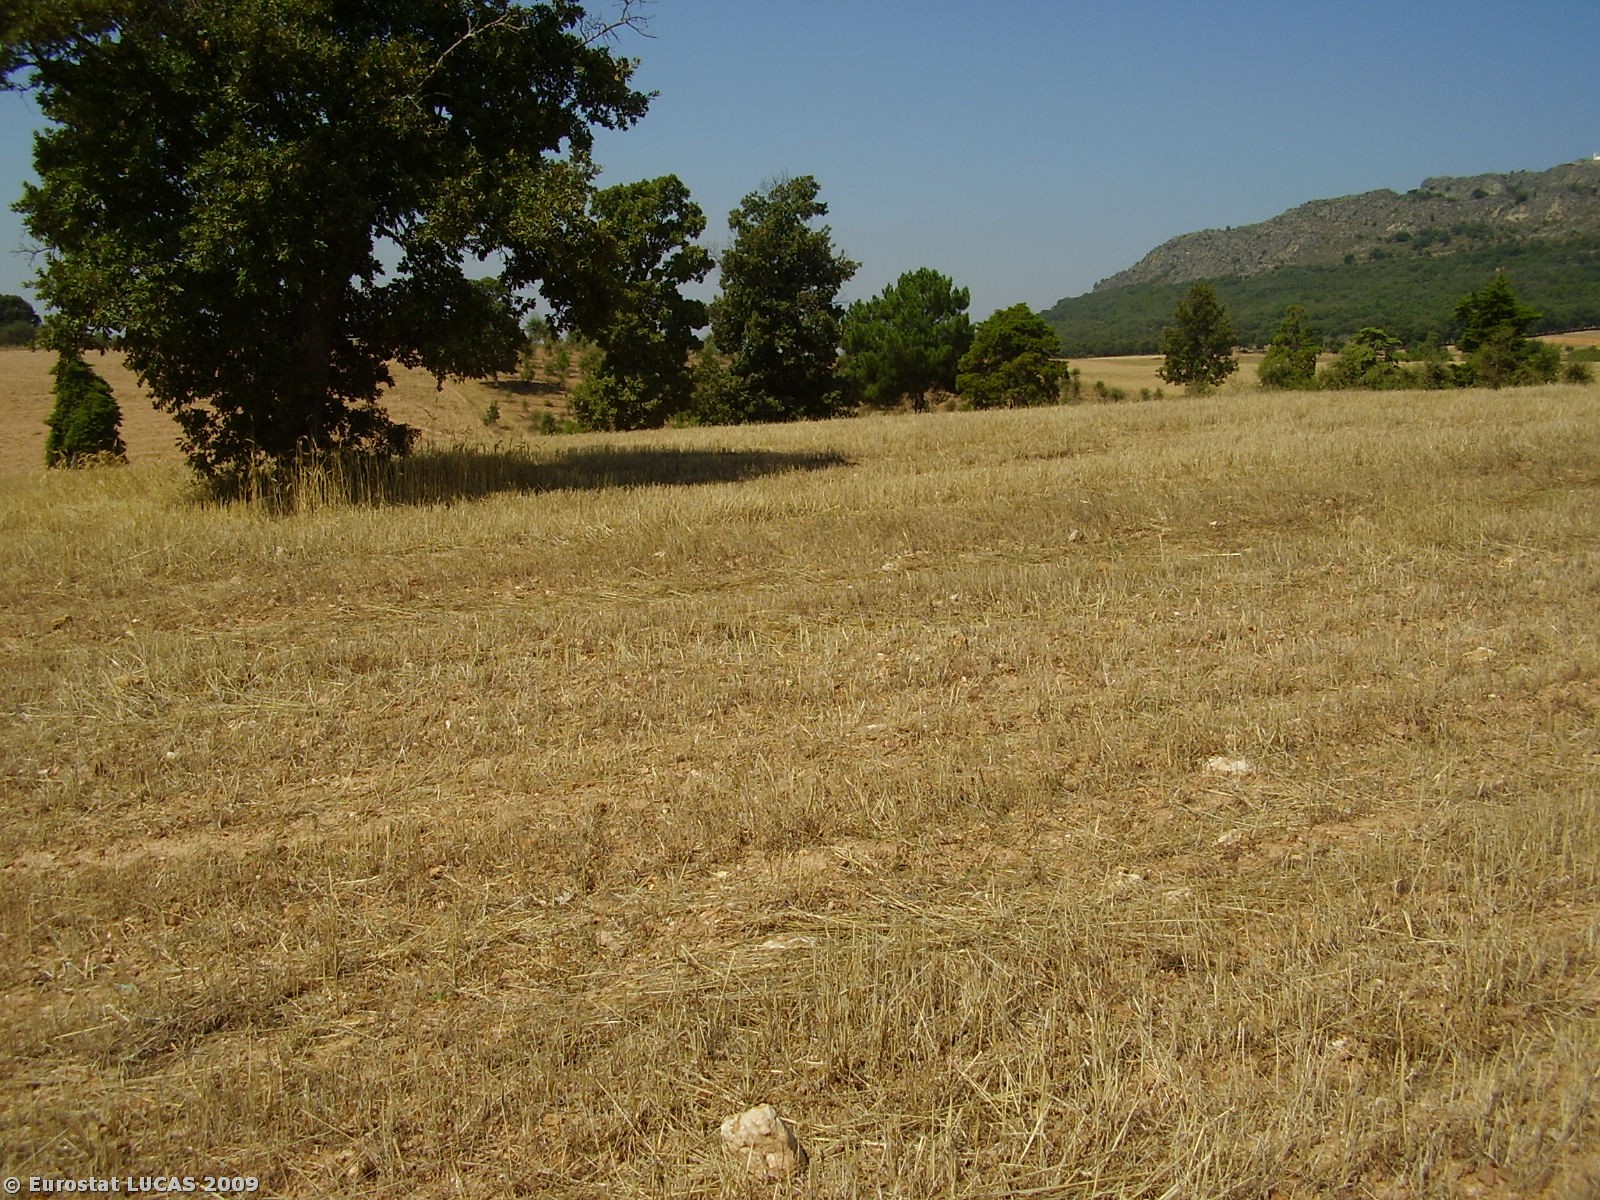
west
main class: Cropland
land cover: Common wheat
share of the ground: < 10 %
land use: Agriculture (excluding fallow land and kitchen gardens)
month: August
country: PT
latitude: 41.3079
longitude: -6.7194
